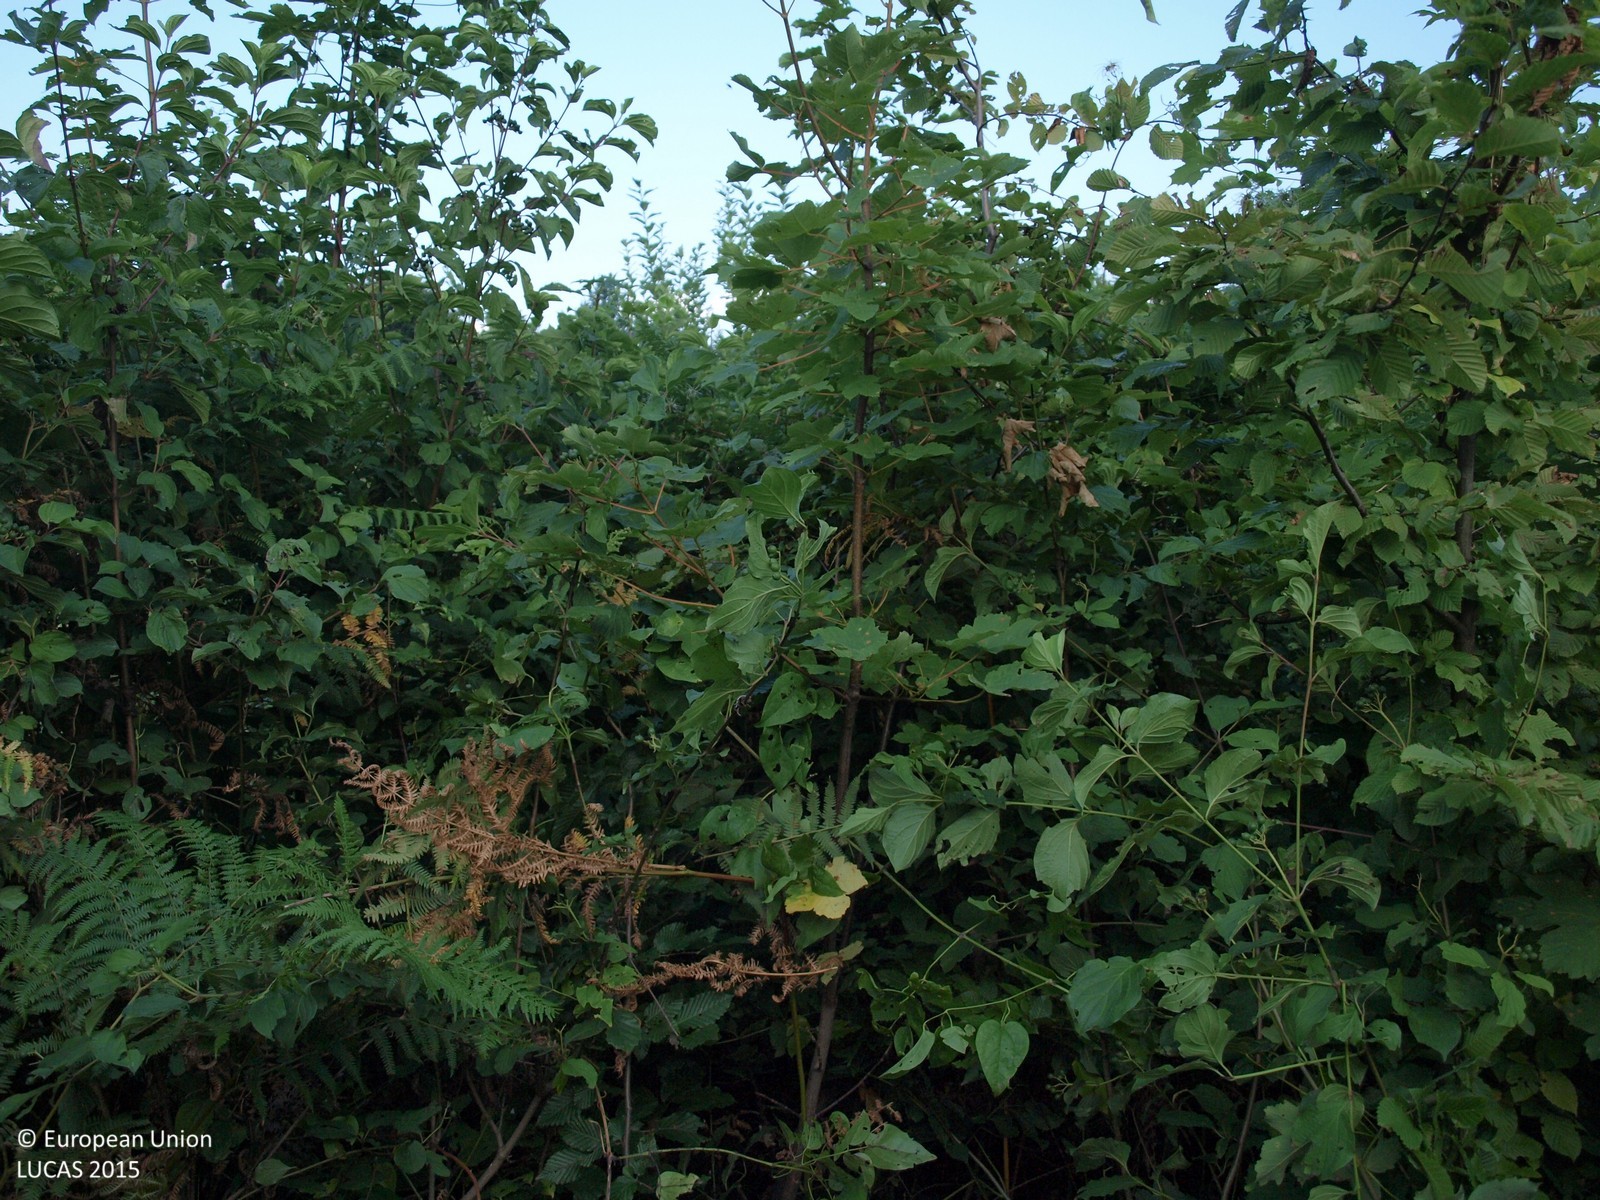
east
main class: Woodland
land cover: Broadleaved woodland
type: beech forest
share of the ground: > 75 %
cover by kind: broadleaved forest trees 100 %
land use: Forestry
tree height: < 5 m
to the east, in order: Broadleaved woodland; Tracks; Broadleaved woodland
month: August
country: HR
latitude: 45.9902
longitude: 16.2087
